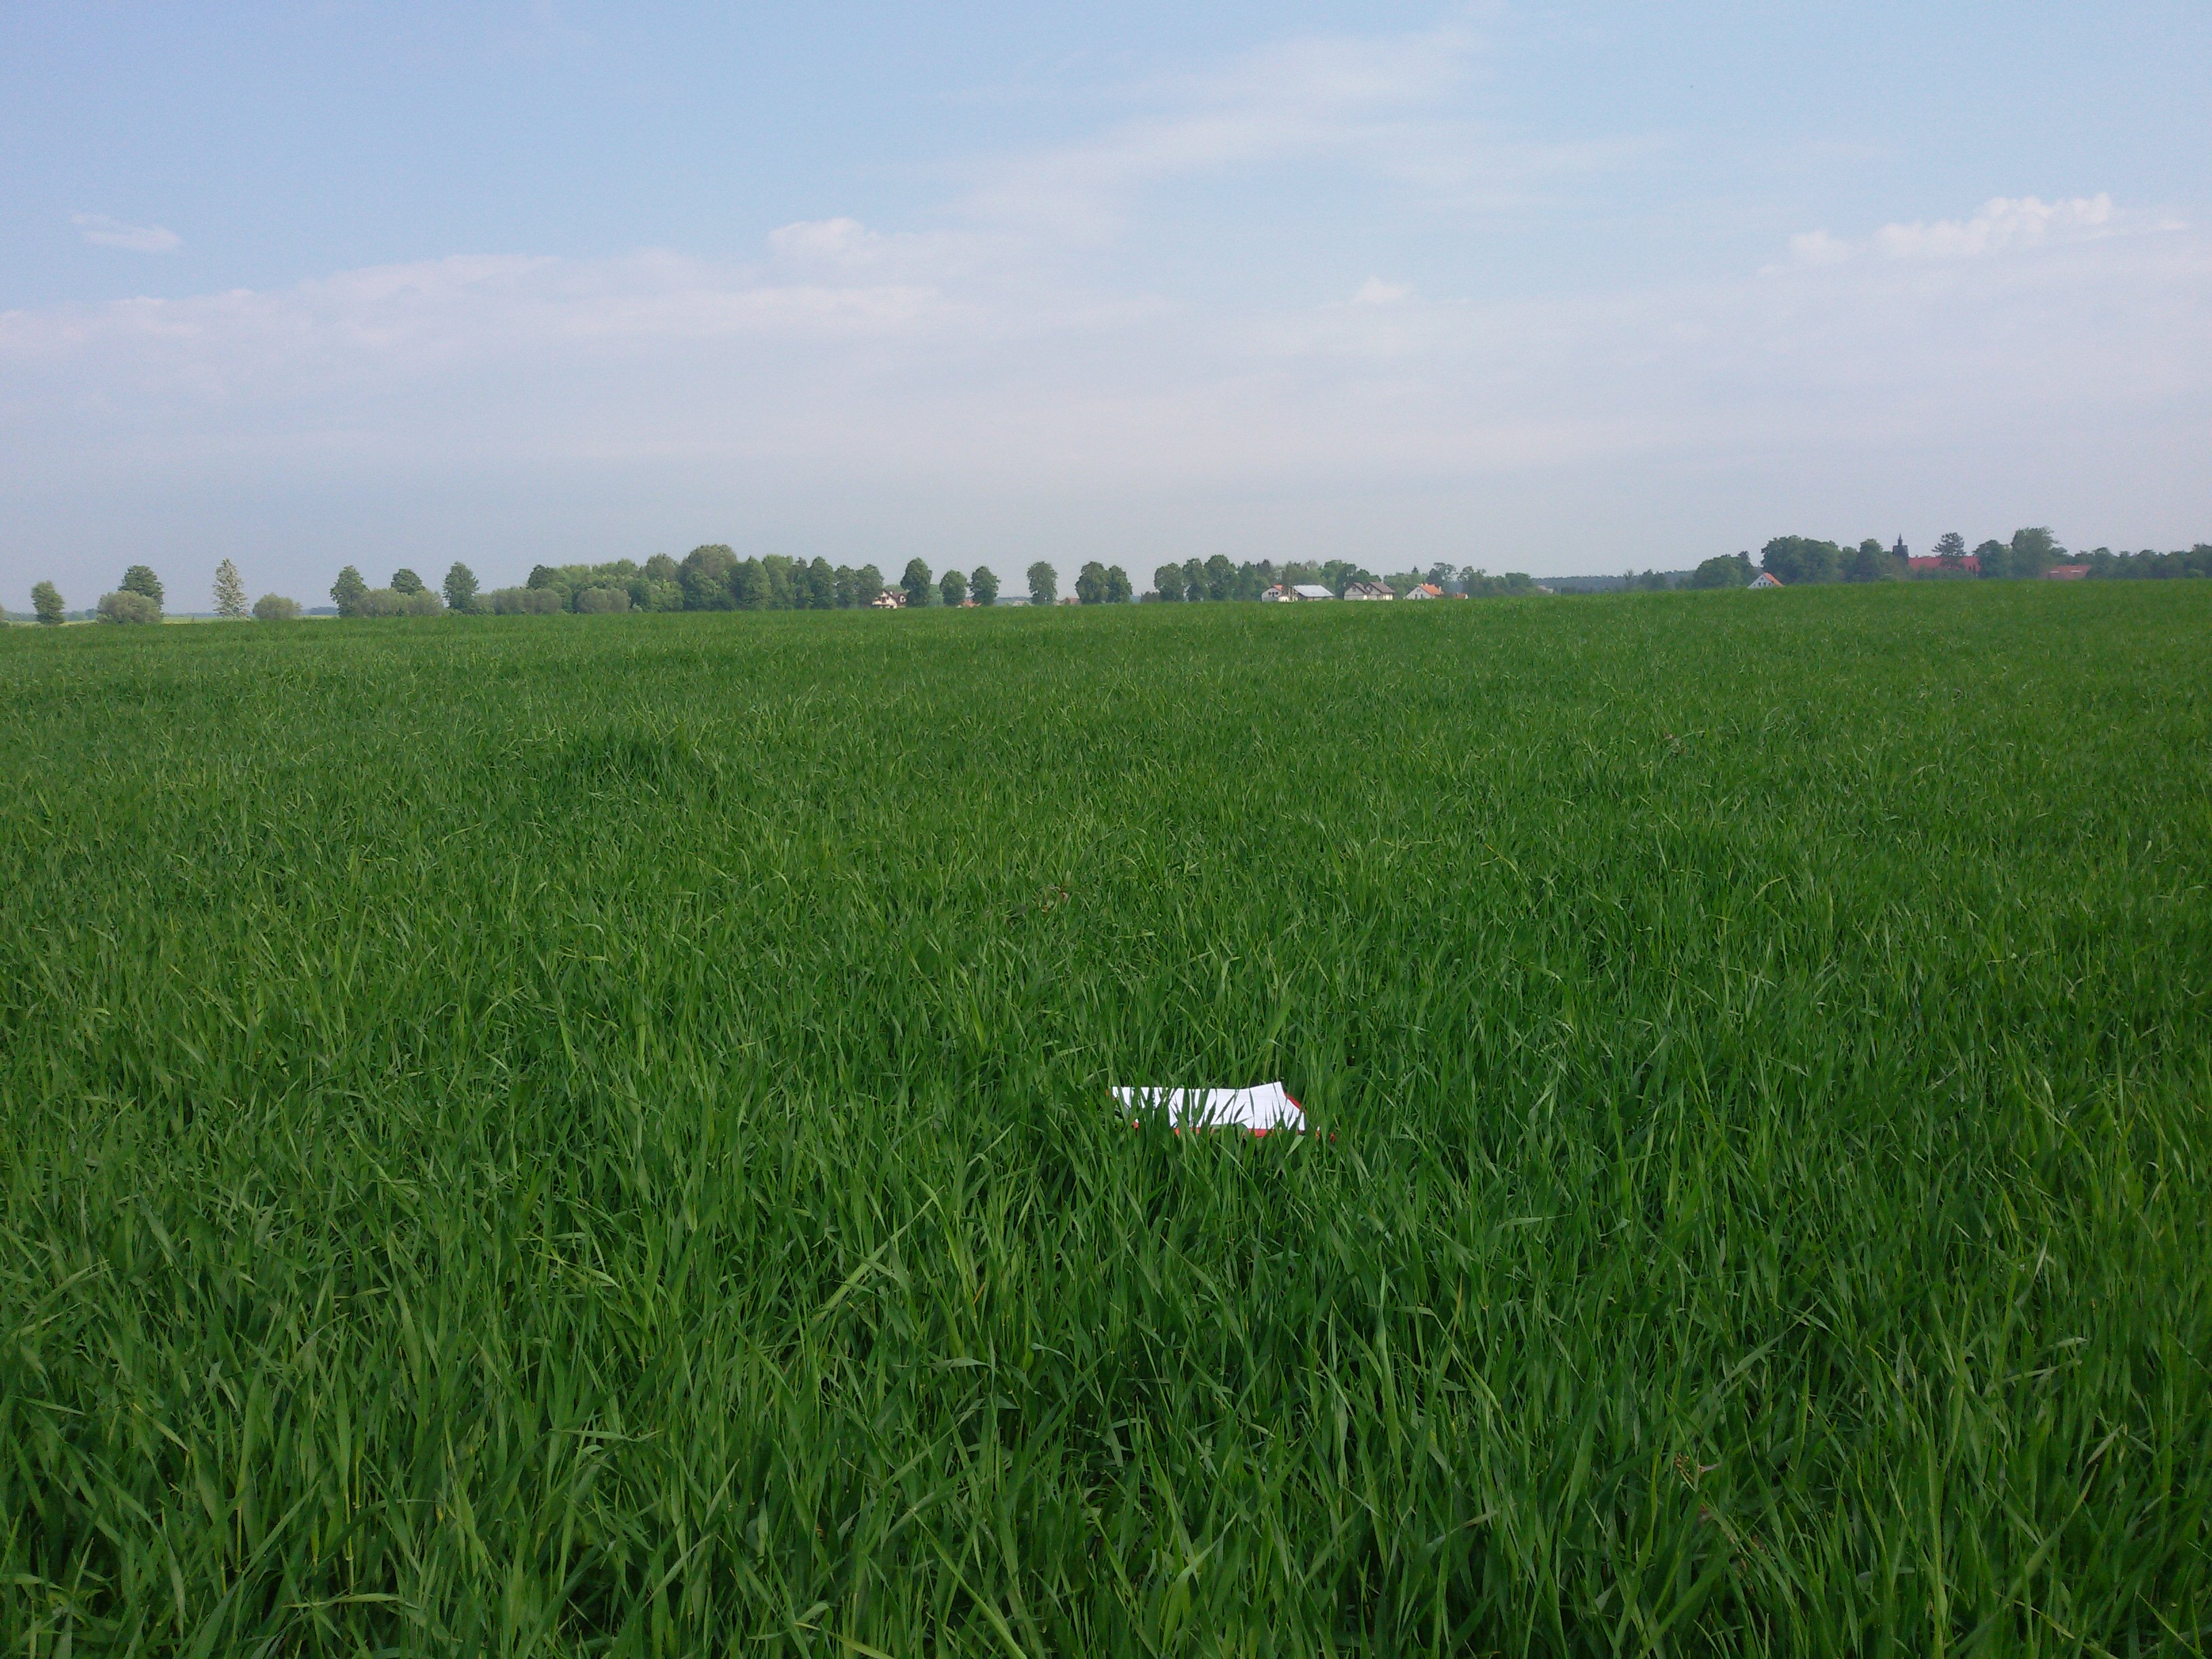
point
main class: Cropland
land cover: Barley
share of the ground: > 75 %
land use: Agriculture (excluding fallow land and kitchen gardens)
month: May
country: PL
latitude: 53.8550
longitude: 22.2072
